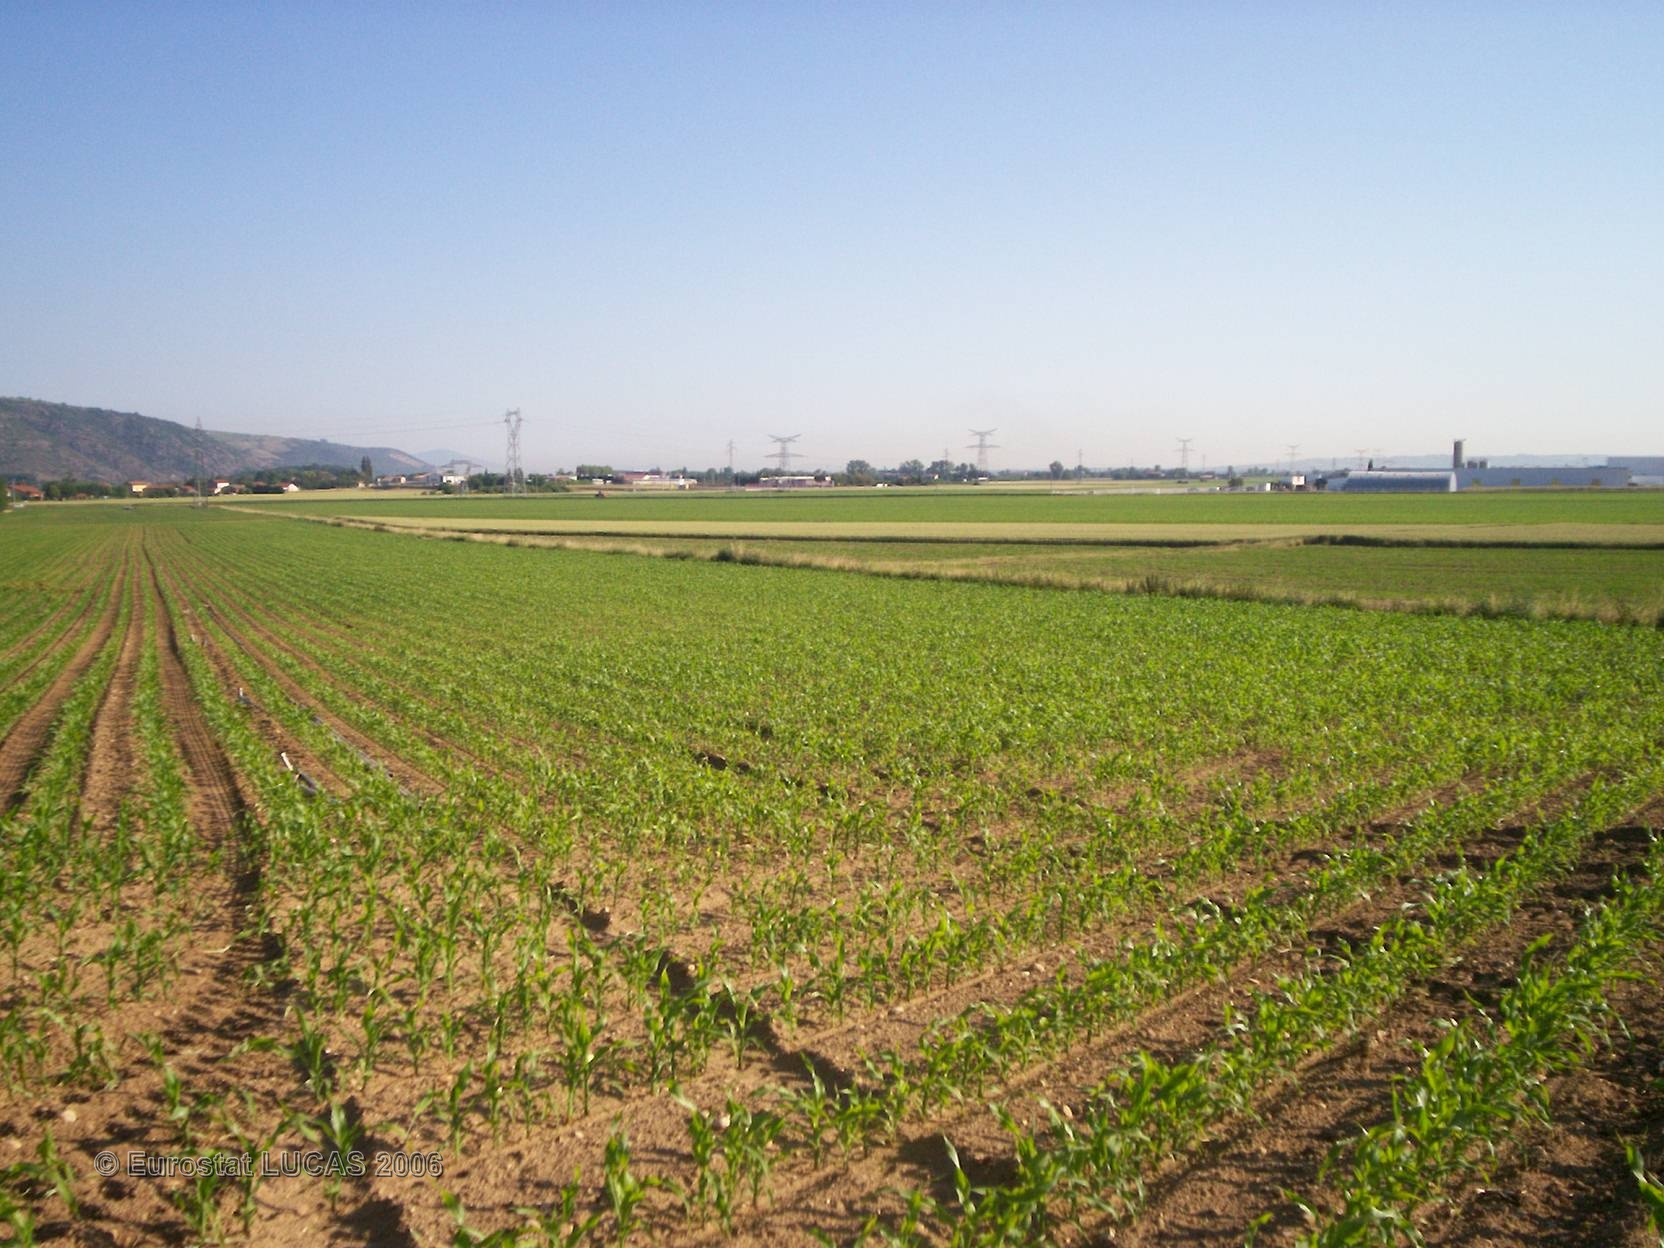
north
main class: Cropland
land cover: Maize
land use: Agriculture (excluding fallow land and kitchen gardens)
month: June
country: FR
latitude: 45.2149
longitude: 4.8224
